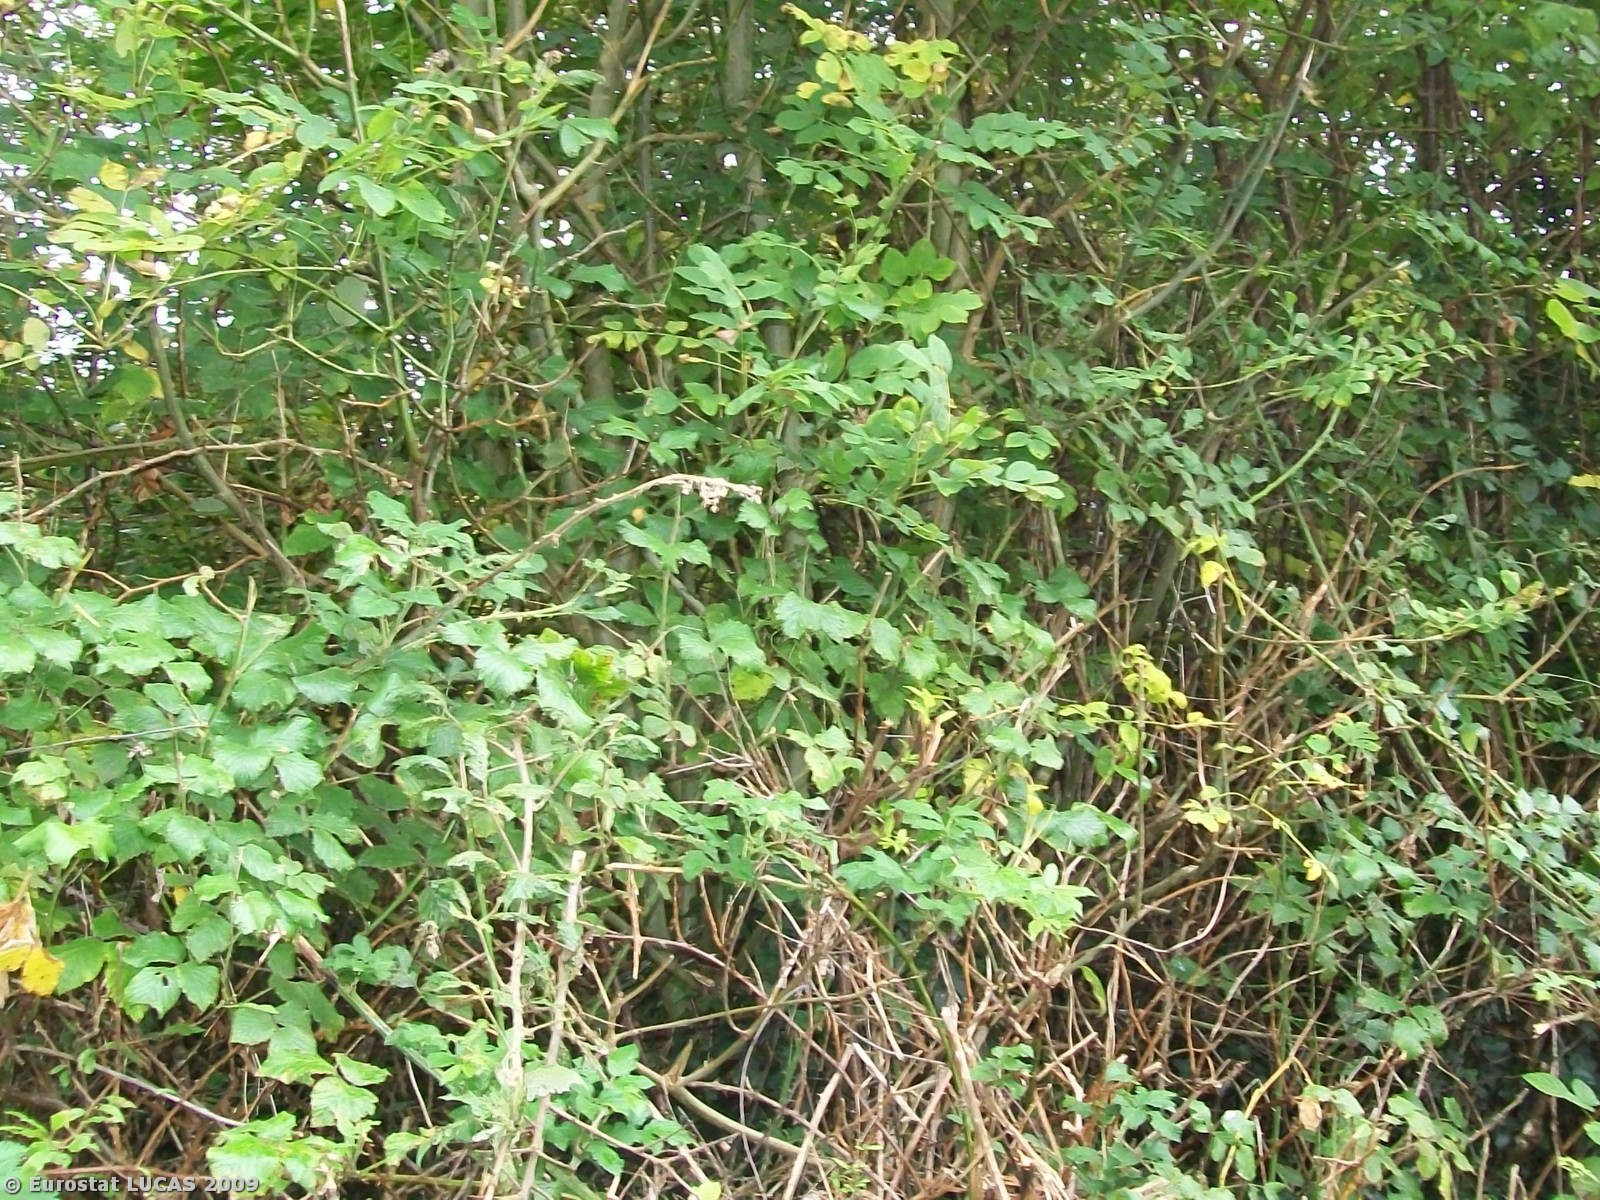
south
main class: Artificial land
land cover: Non built-up linear features
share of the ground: > 75 %
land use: Road transport
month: September
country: IE
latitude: 53.0235
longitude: -8.3005
